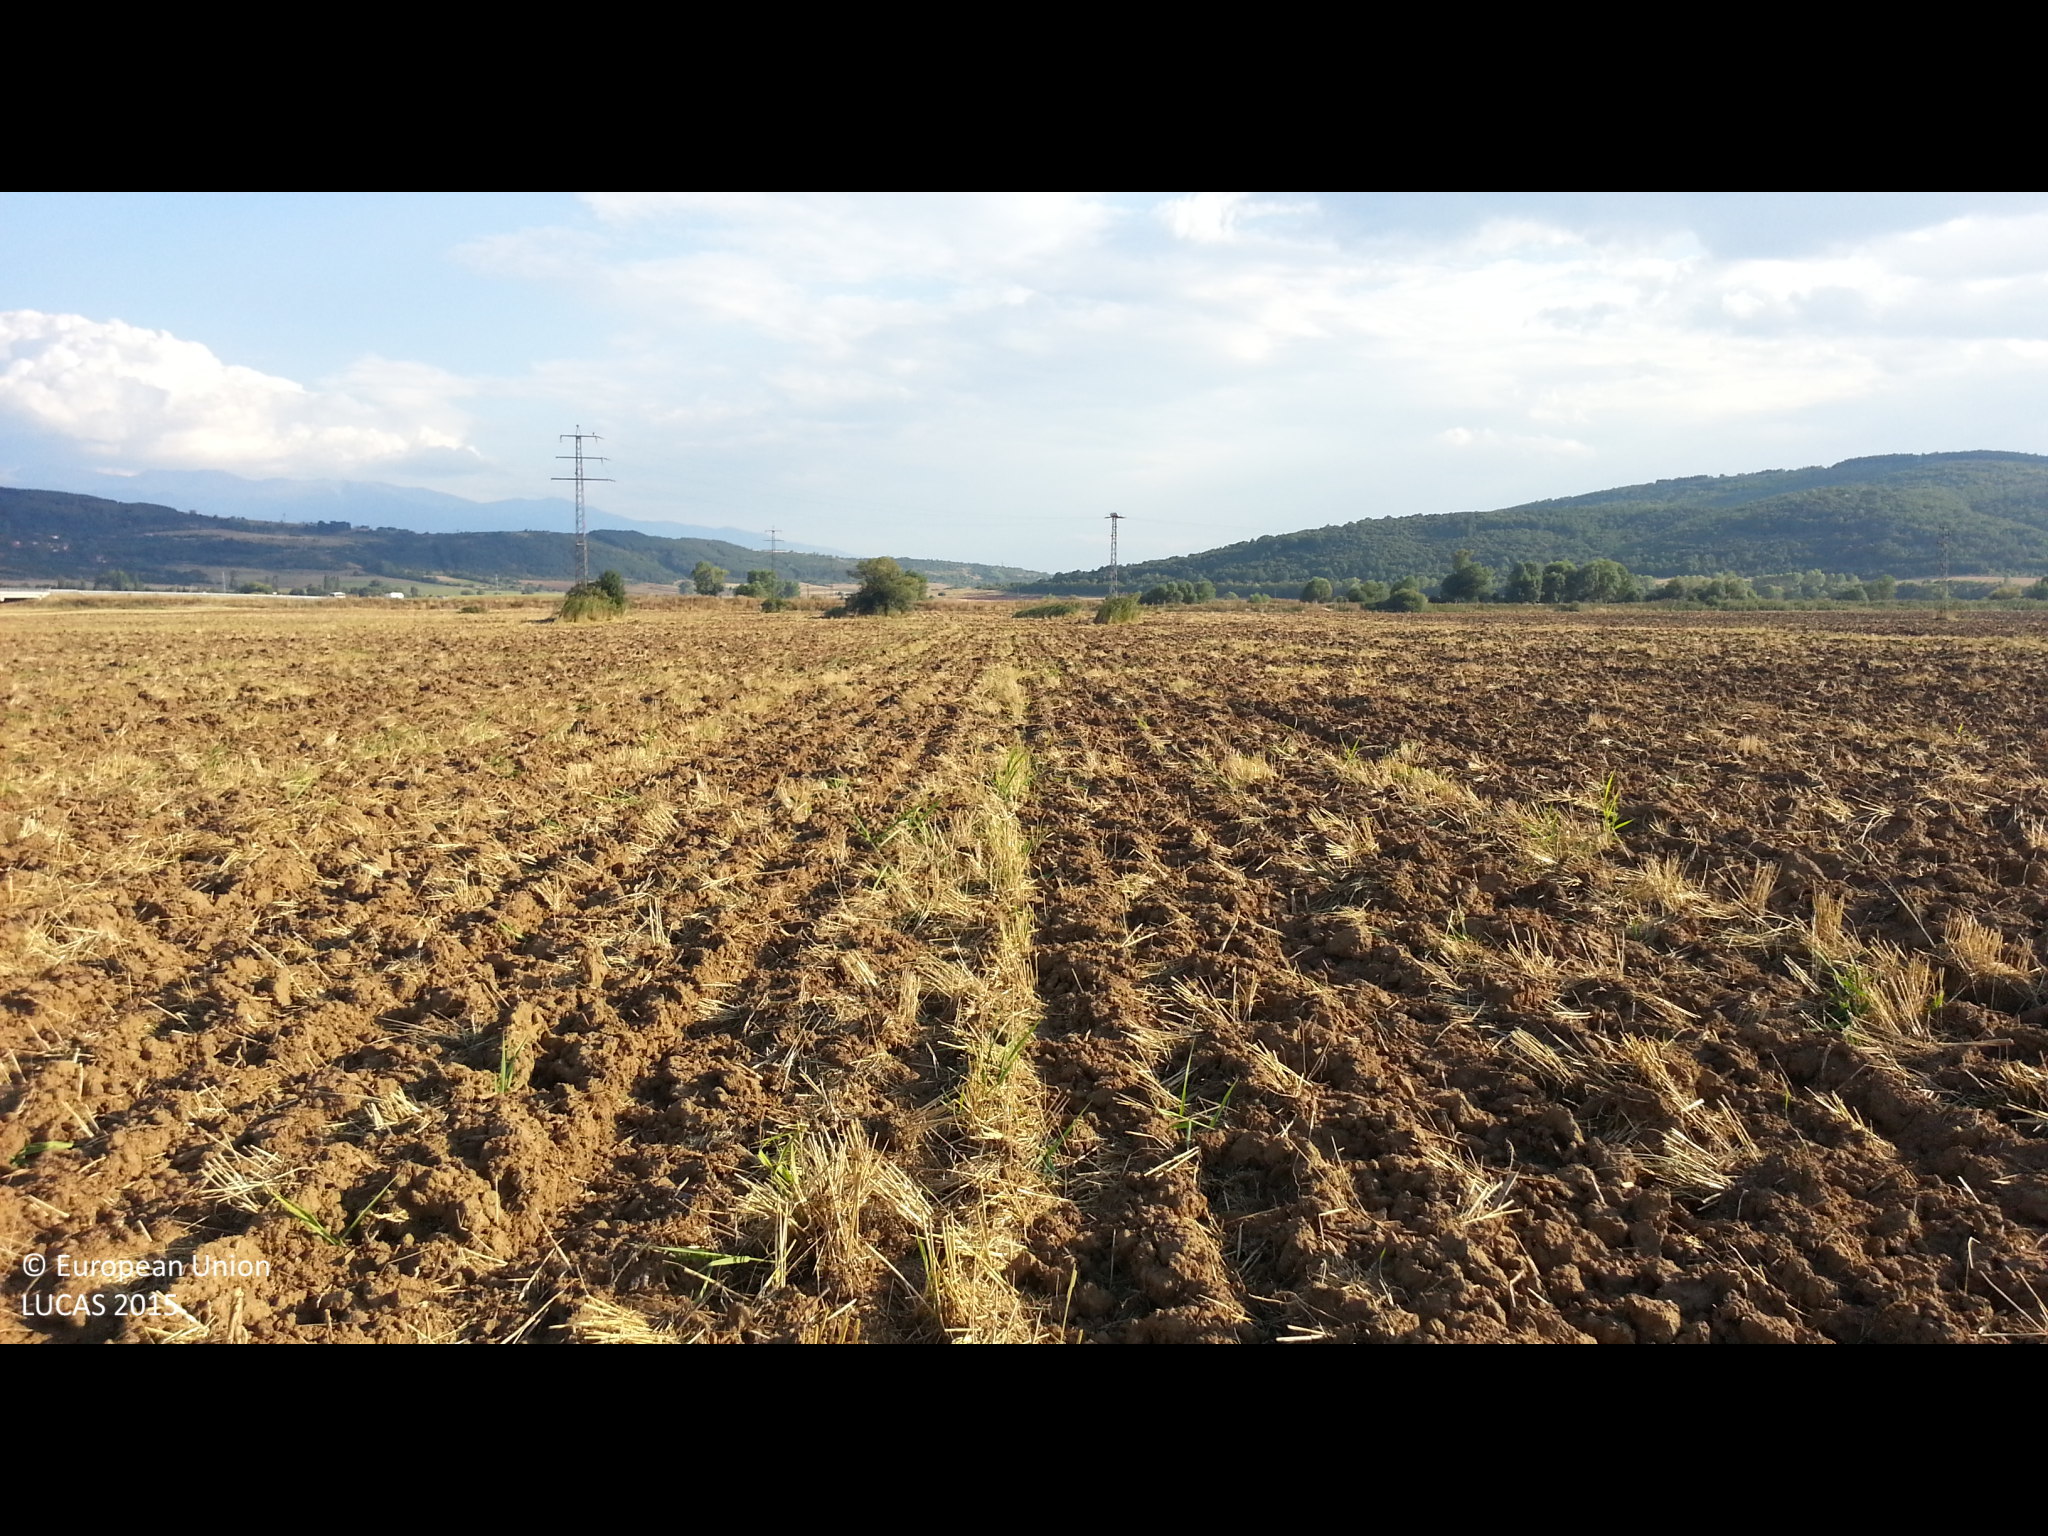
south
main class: Cropland
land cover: Common wheat
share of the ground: < 10 %
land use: Agriculture (excluding fallow land and kitchen gardens)
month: August
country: BG
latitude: 42.4181
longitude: 23.1171
